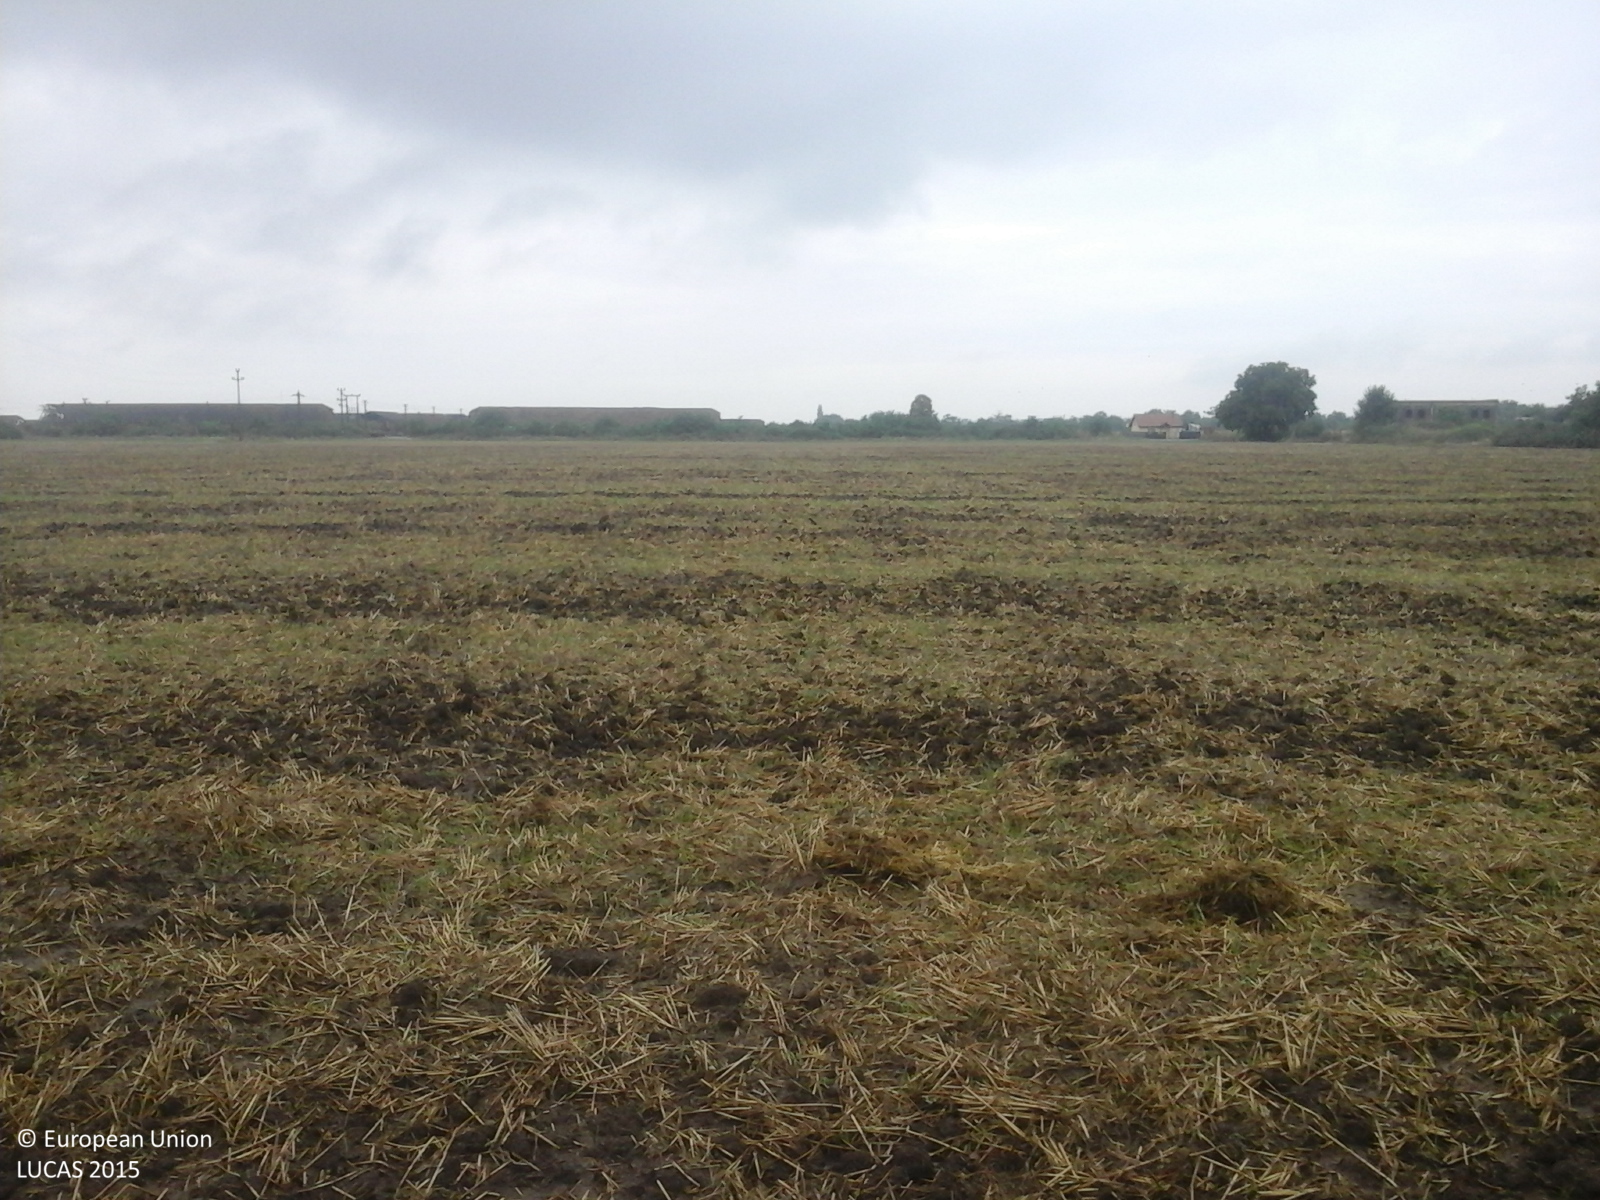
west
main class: Cropland
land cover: Common wheat
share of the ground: < 10 %
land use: Agriculture (excluding fallow land and kitchen gardens)
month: August
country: RO
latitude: 45.6211
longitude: 21.1483
